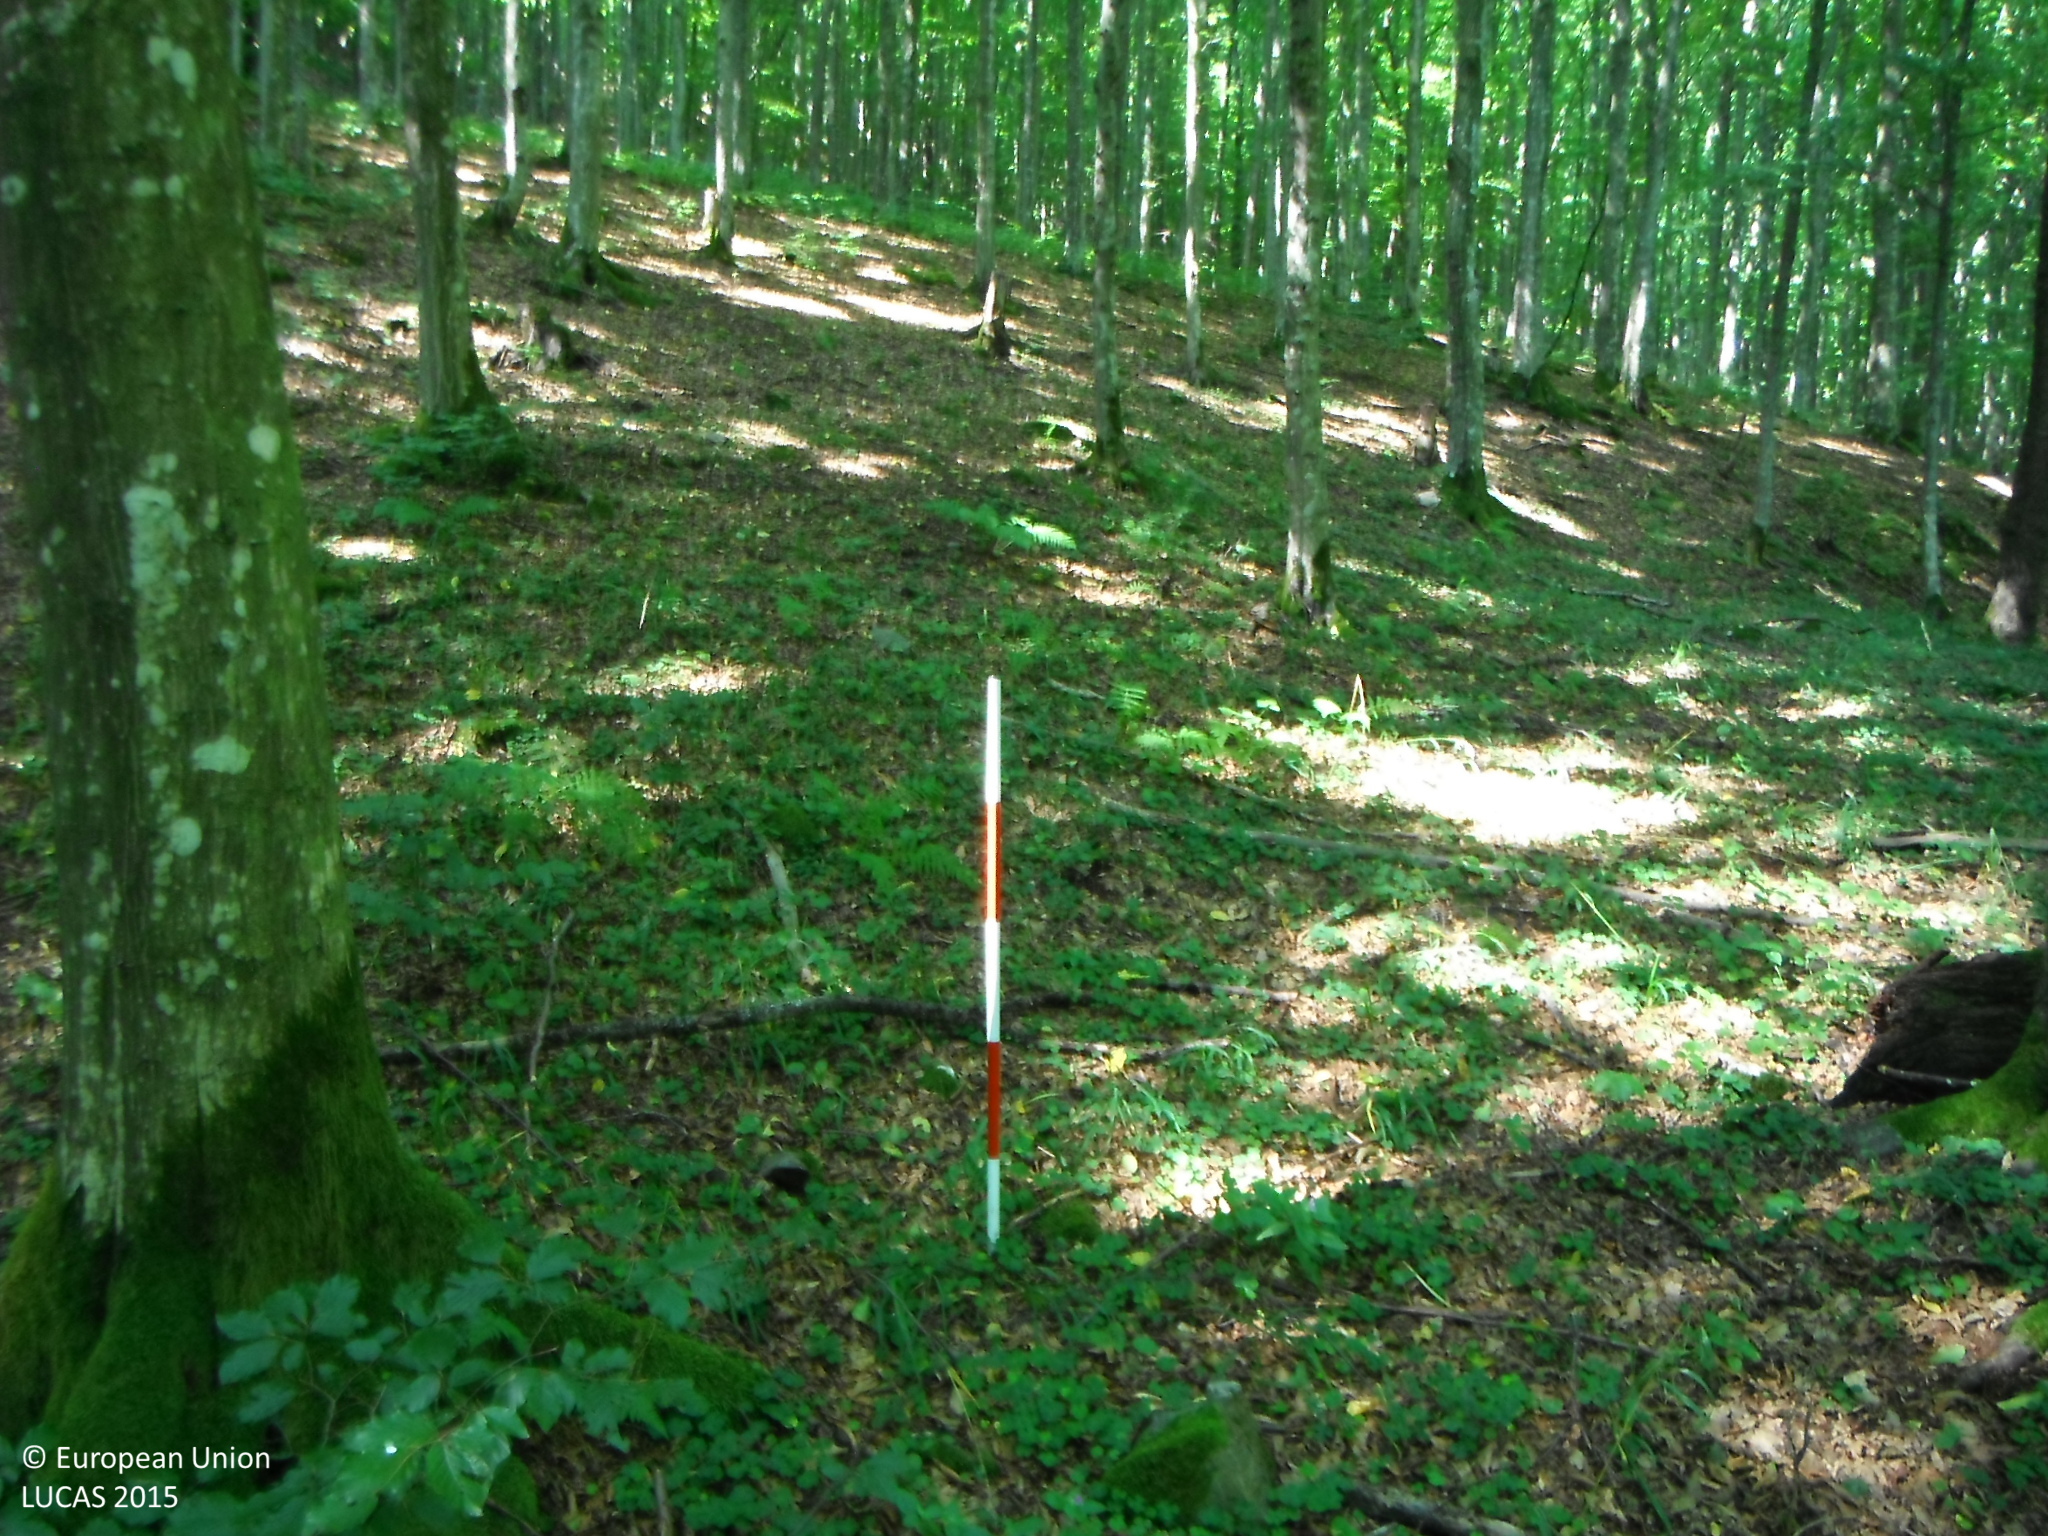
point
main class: Woodland
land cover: Broadleaved woodland
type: mesophytic deciduous forest
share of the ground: > 75 %
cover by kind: broadleaved forest trees 100 %
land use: Forestry
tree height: > 5 m
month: August
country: SK
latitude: 48.6942
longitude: 20.5650
